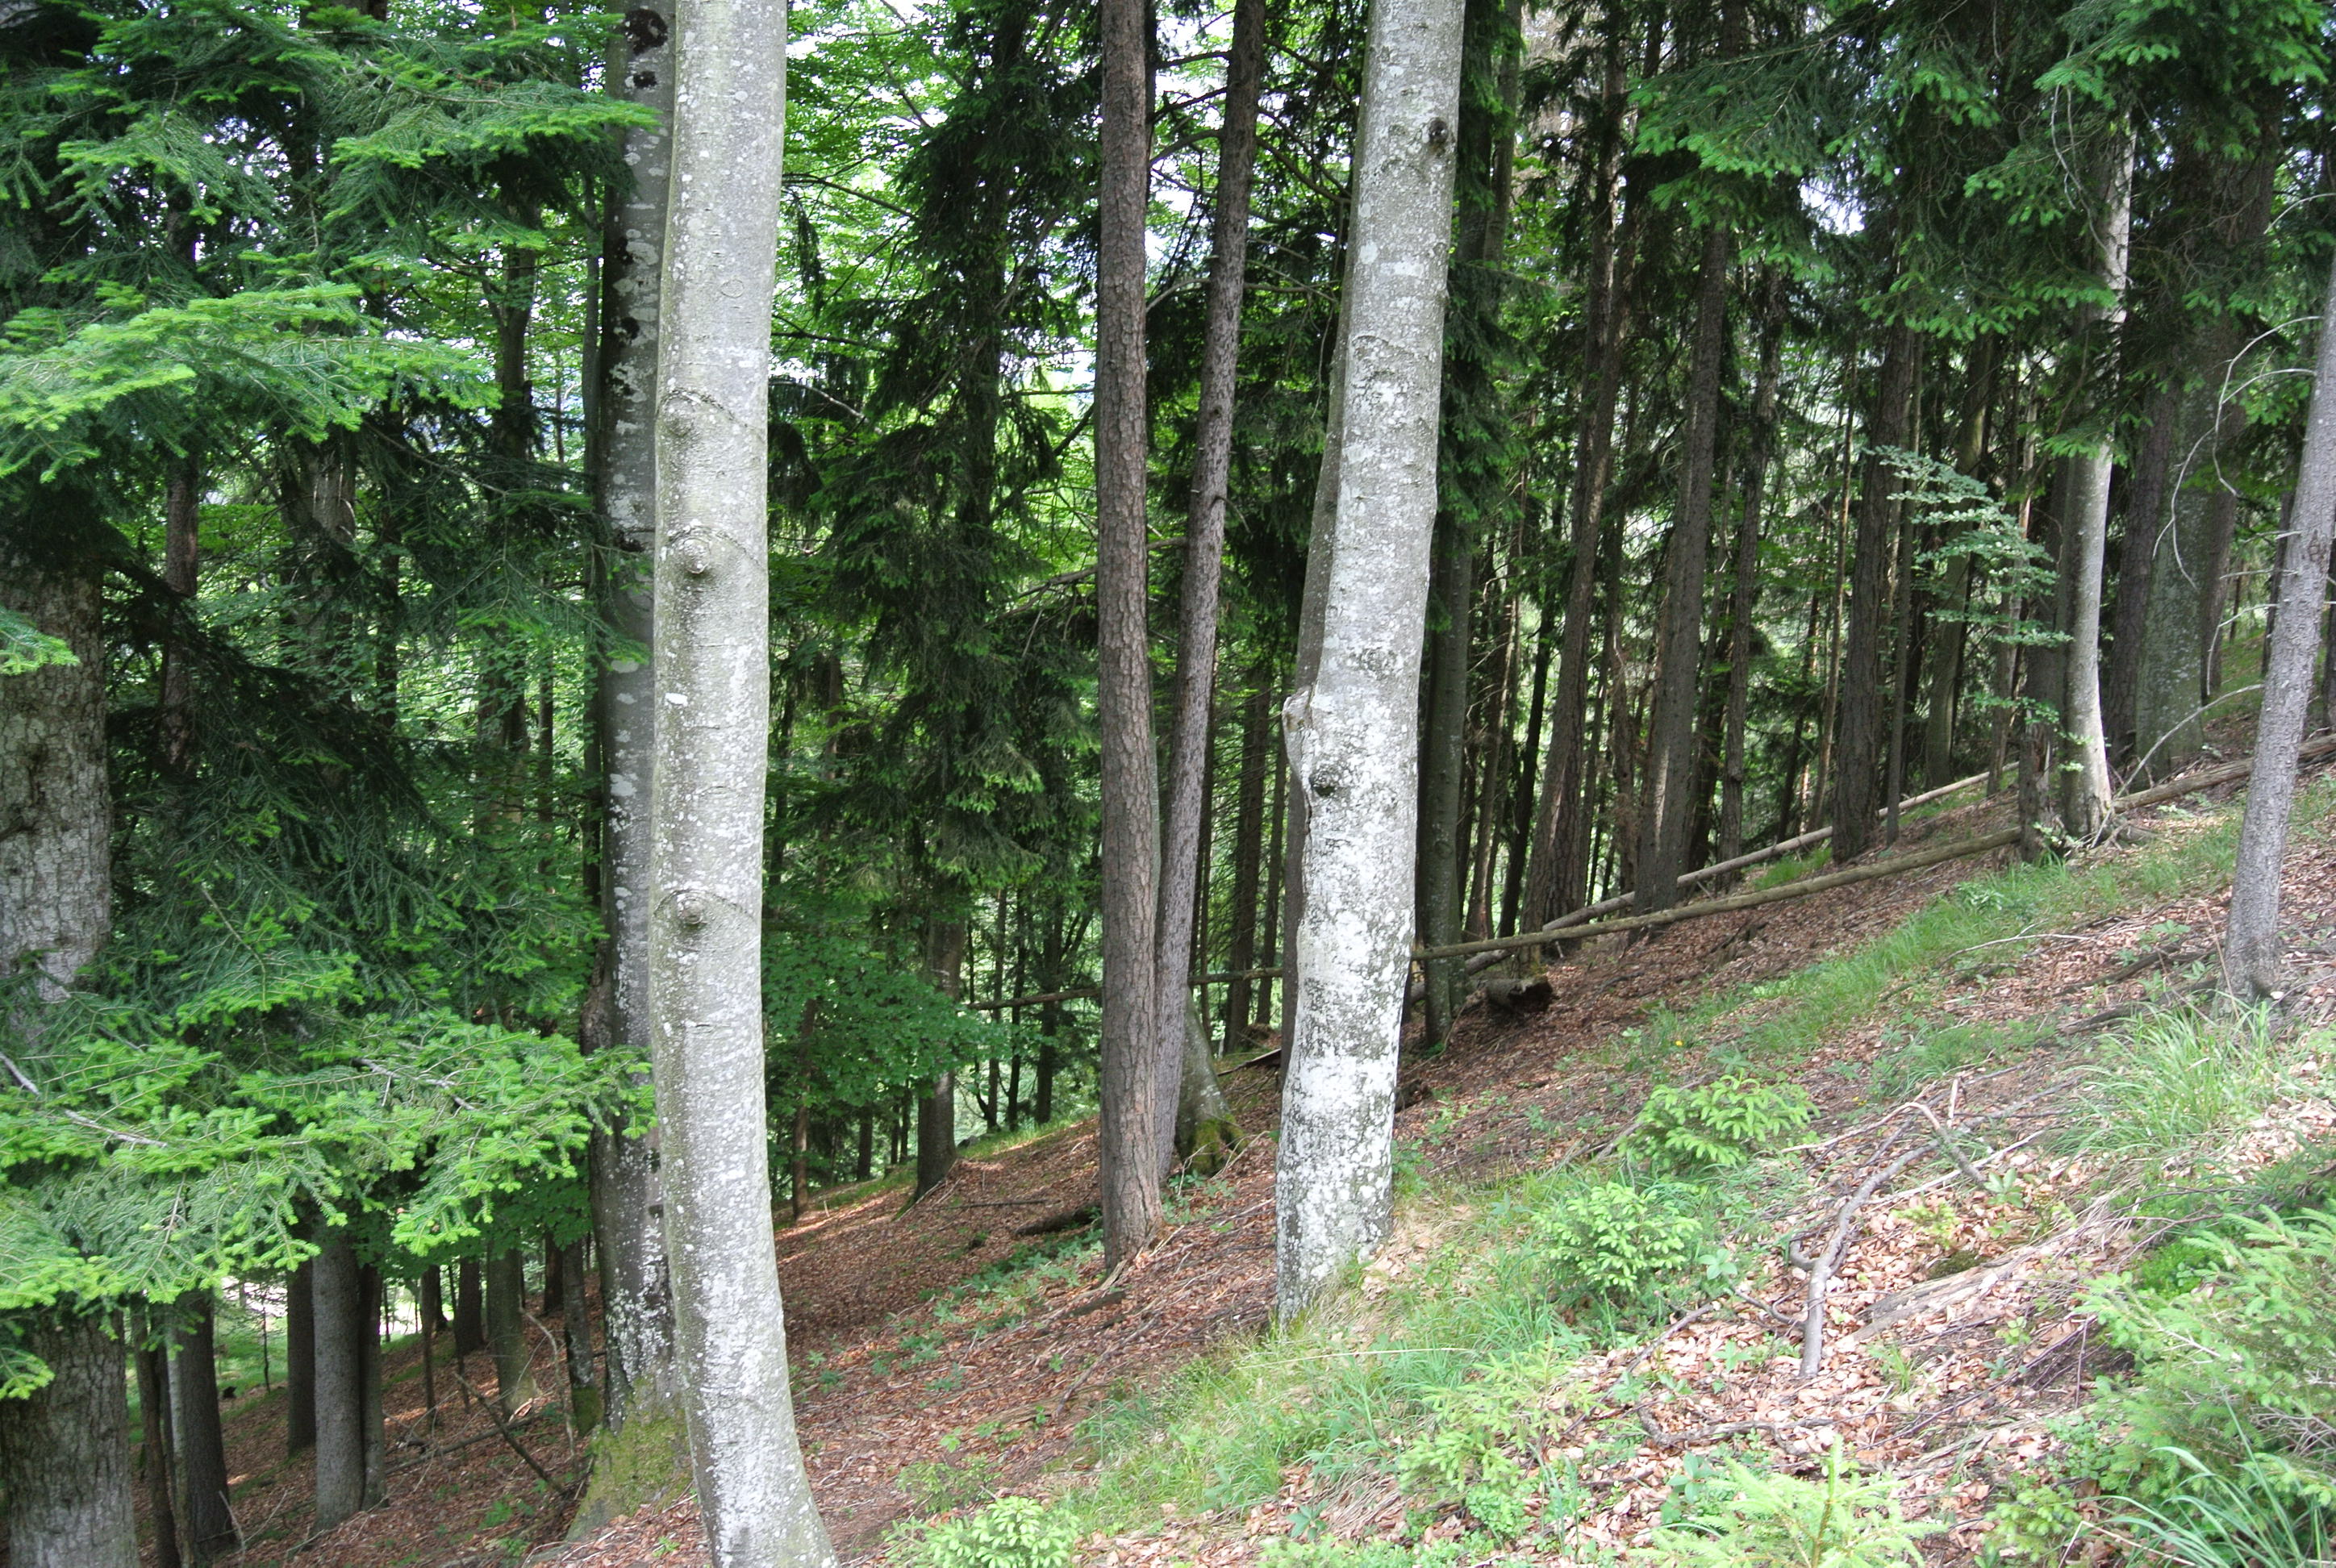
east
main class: Woodland
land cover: Spruce dominated coniferous woodland
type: alpine coniferous forest
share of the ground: > 75 %
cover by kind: coniferous forest trees 100 %
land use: Forestry
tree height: > 5 m
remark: Harvested field
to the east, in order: Spruce dominated coniferous woodland; Spruce dominated mixed woodland; Inland fresh running water; Tracks; Broadleaved woodland; Grassland with sparse tree/shrub cover; Spruce dominated mixed woodland; Tracks; Spruce dominated mixed woodland; Pine dominated coniferous woodland
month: June
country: AT
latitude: 47.8714
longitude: 15.8183
